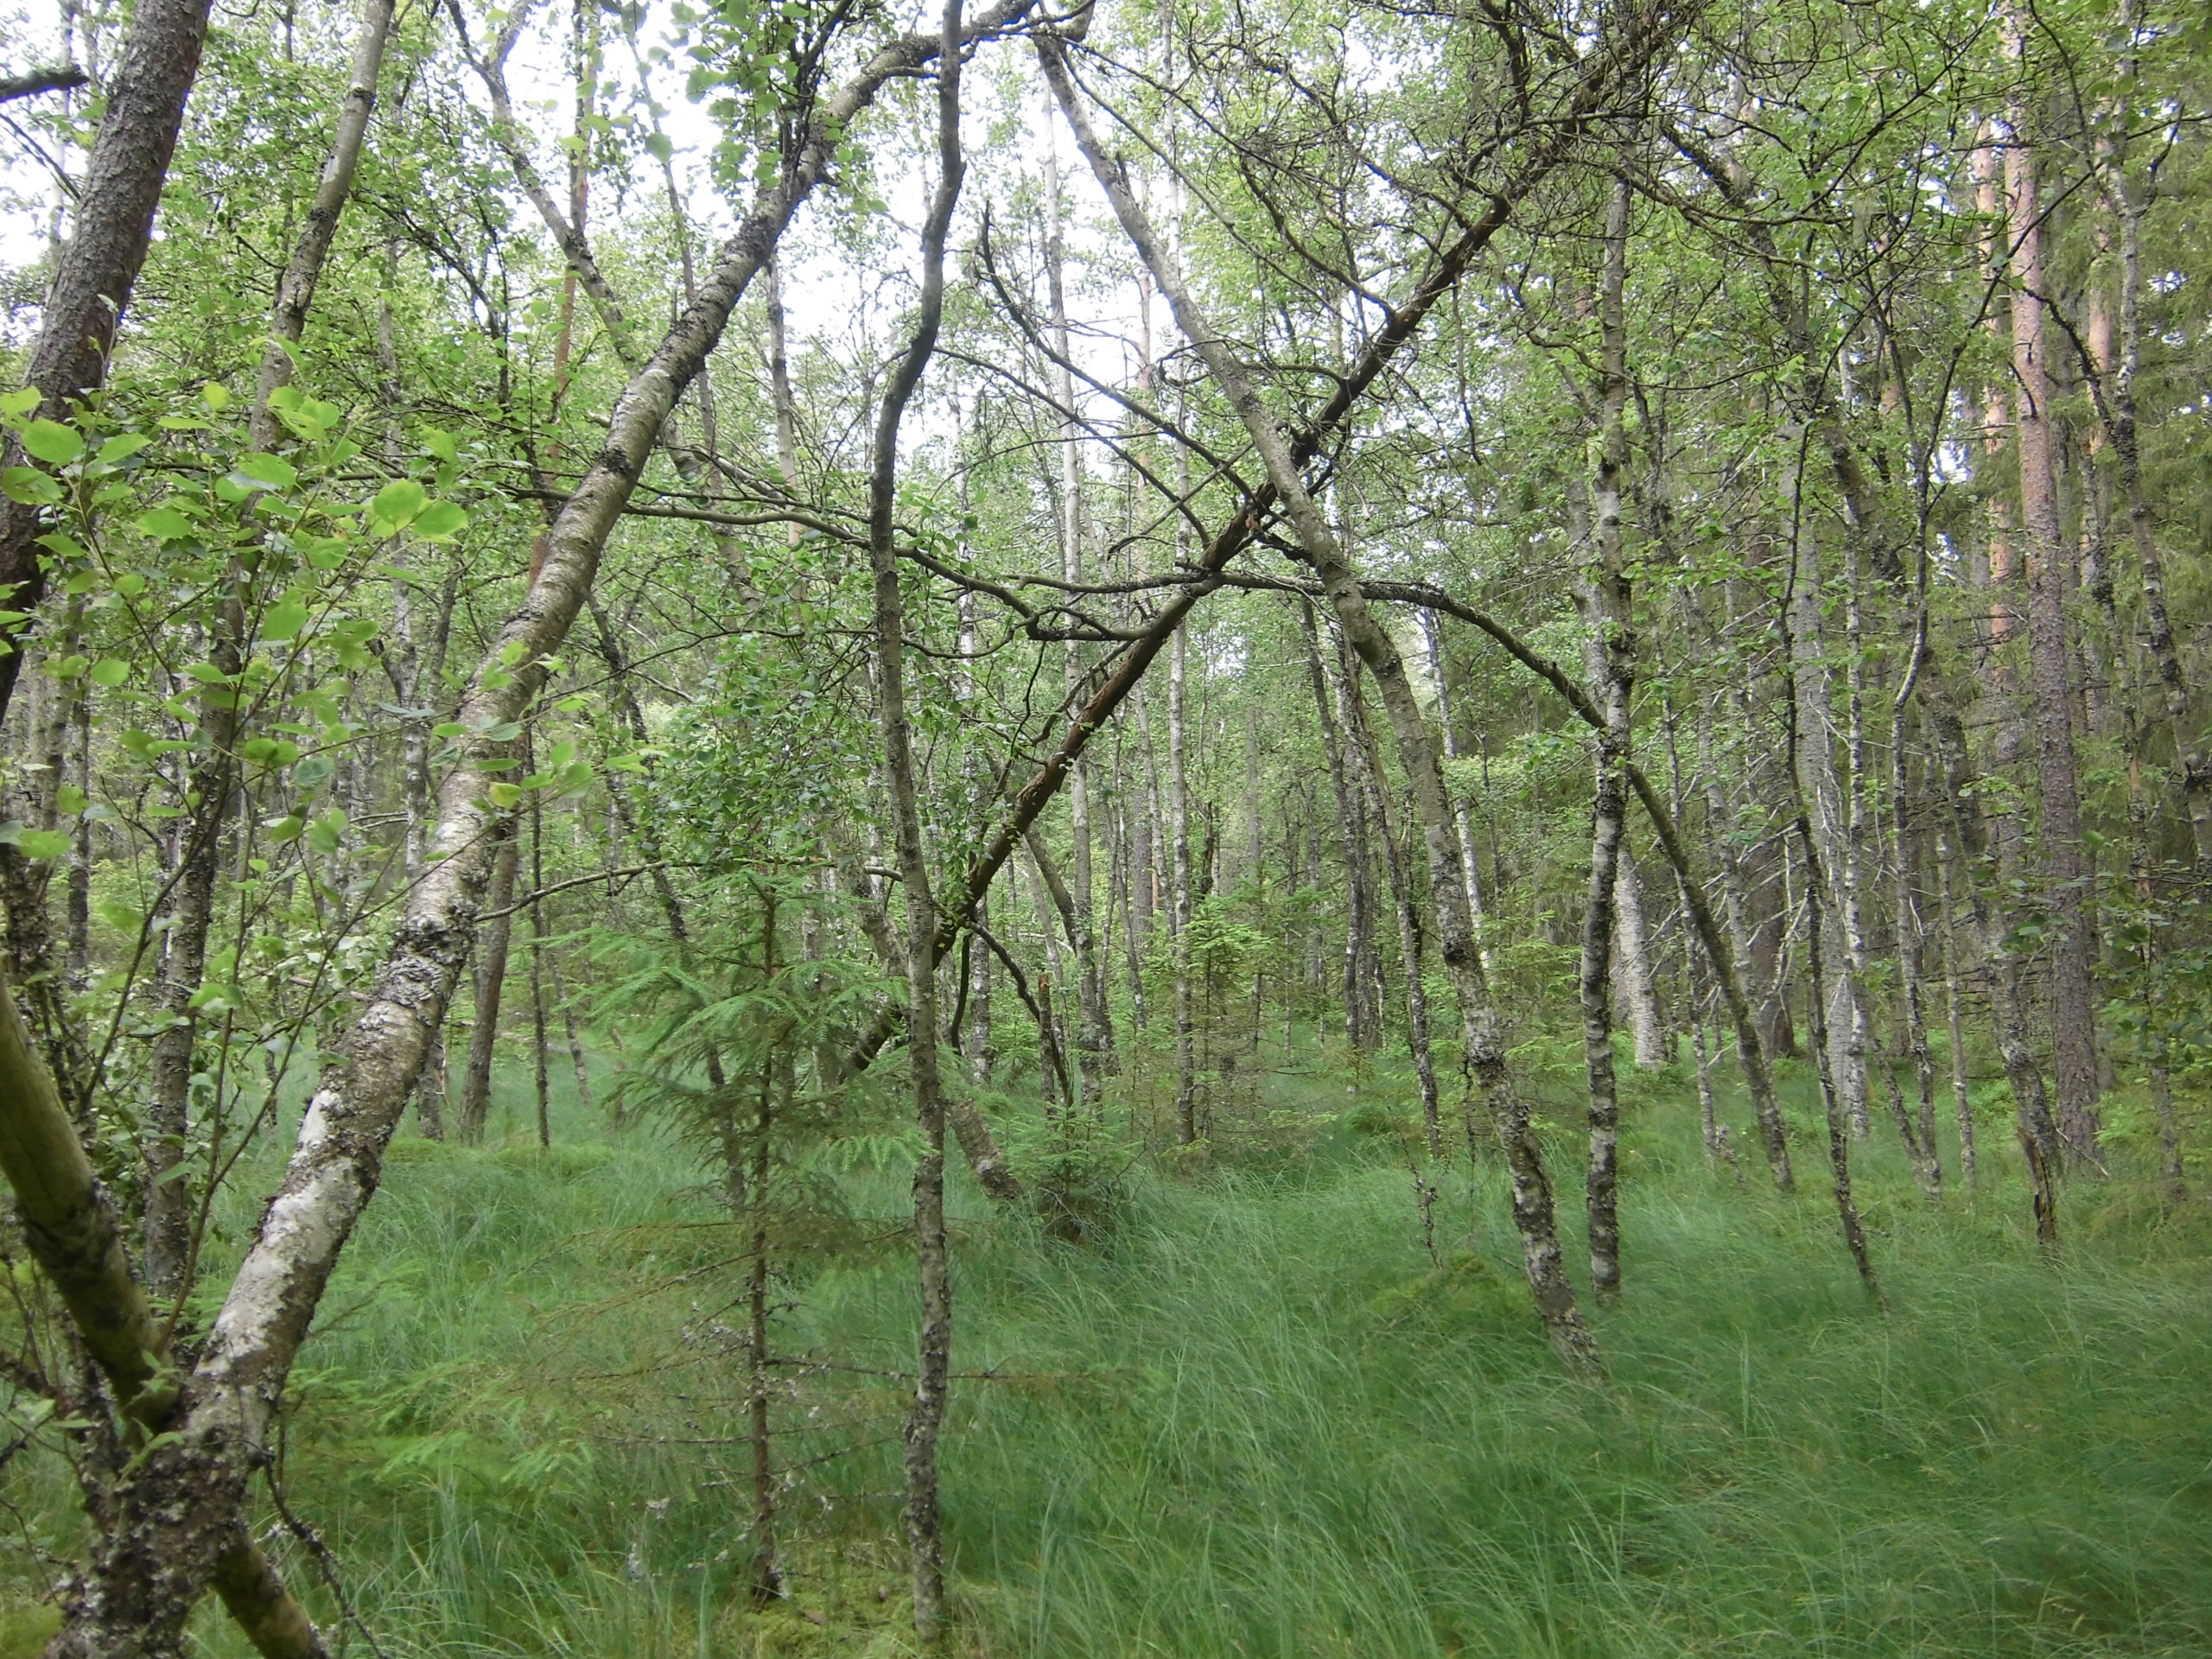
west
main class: Woodland
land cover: Broadleaved woodland
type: mire and swamp forests
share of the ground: 50 - 75 %
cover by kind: broadleaved forest trees 50 %, herbaceous plants 20 %, lichens and mosses 20 %, coniferous forest trees 5 %, shrubs 5 %
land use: Forestry
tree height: > 5 m
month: July
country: SE
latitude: 57.3590
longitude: 14.8003
